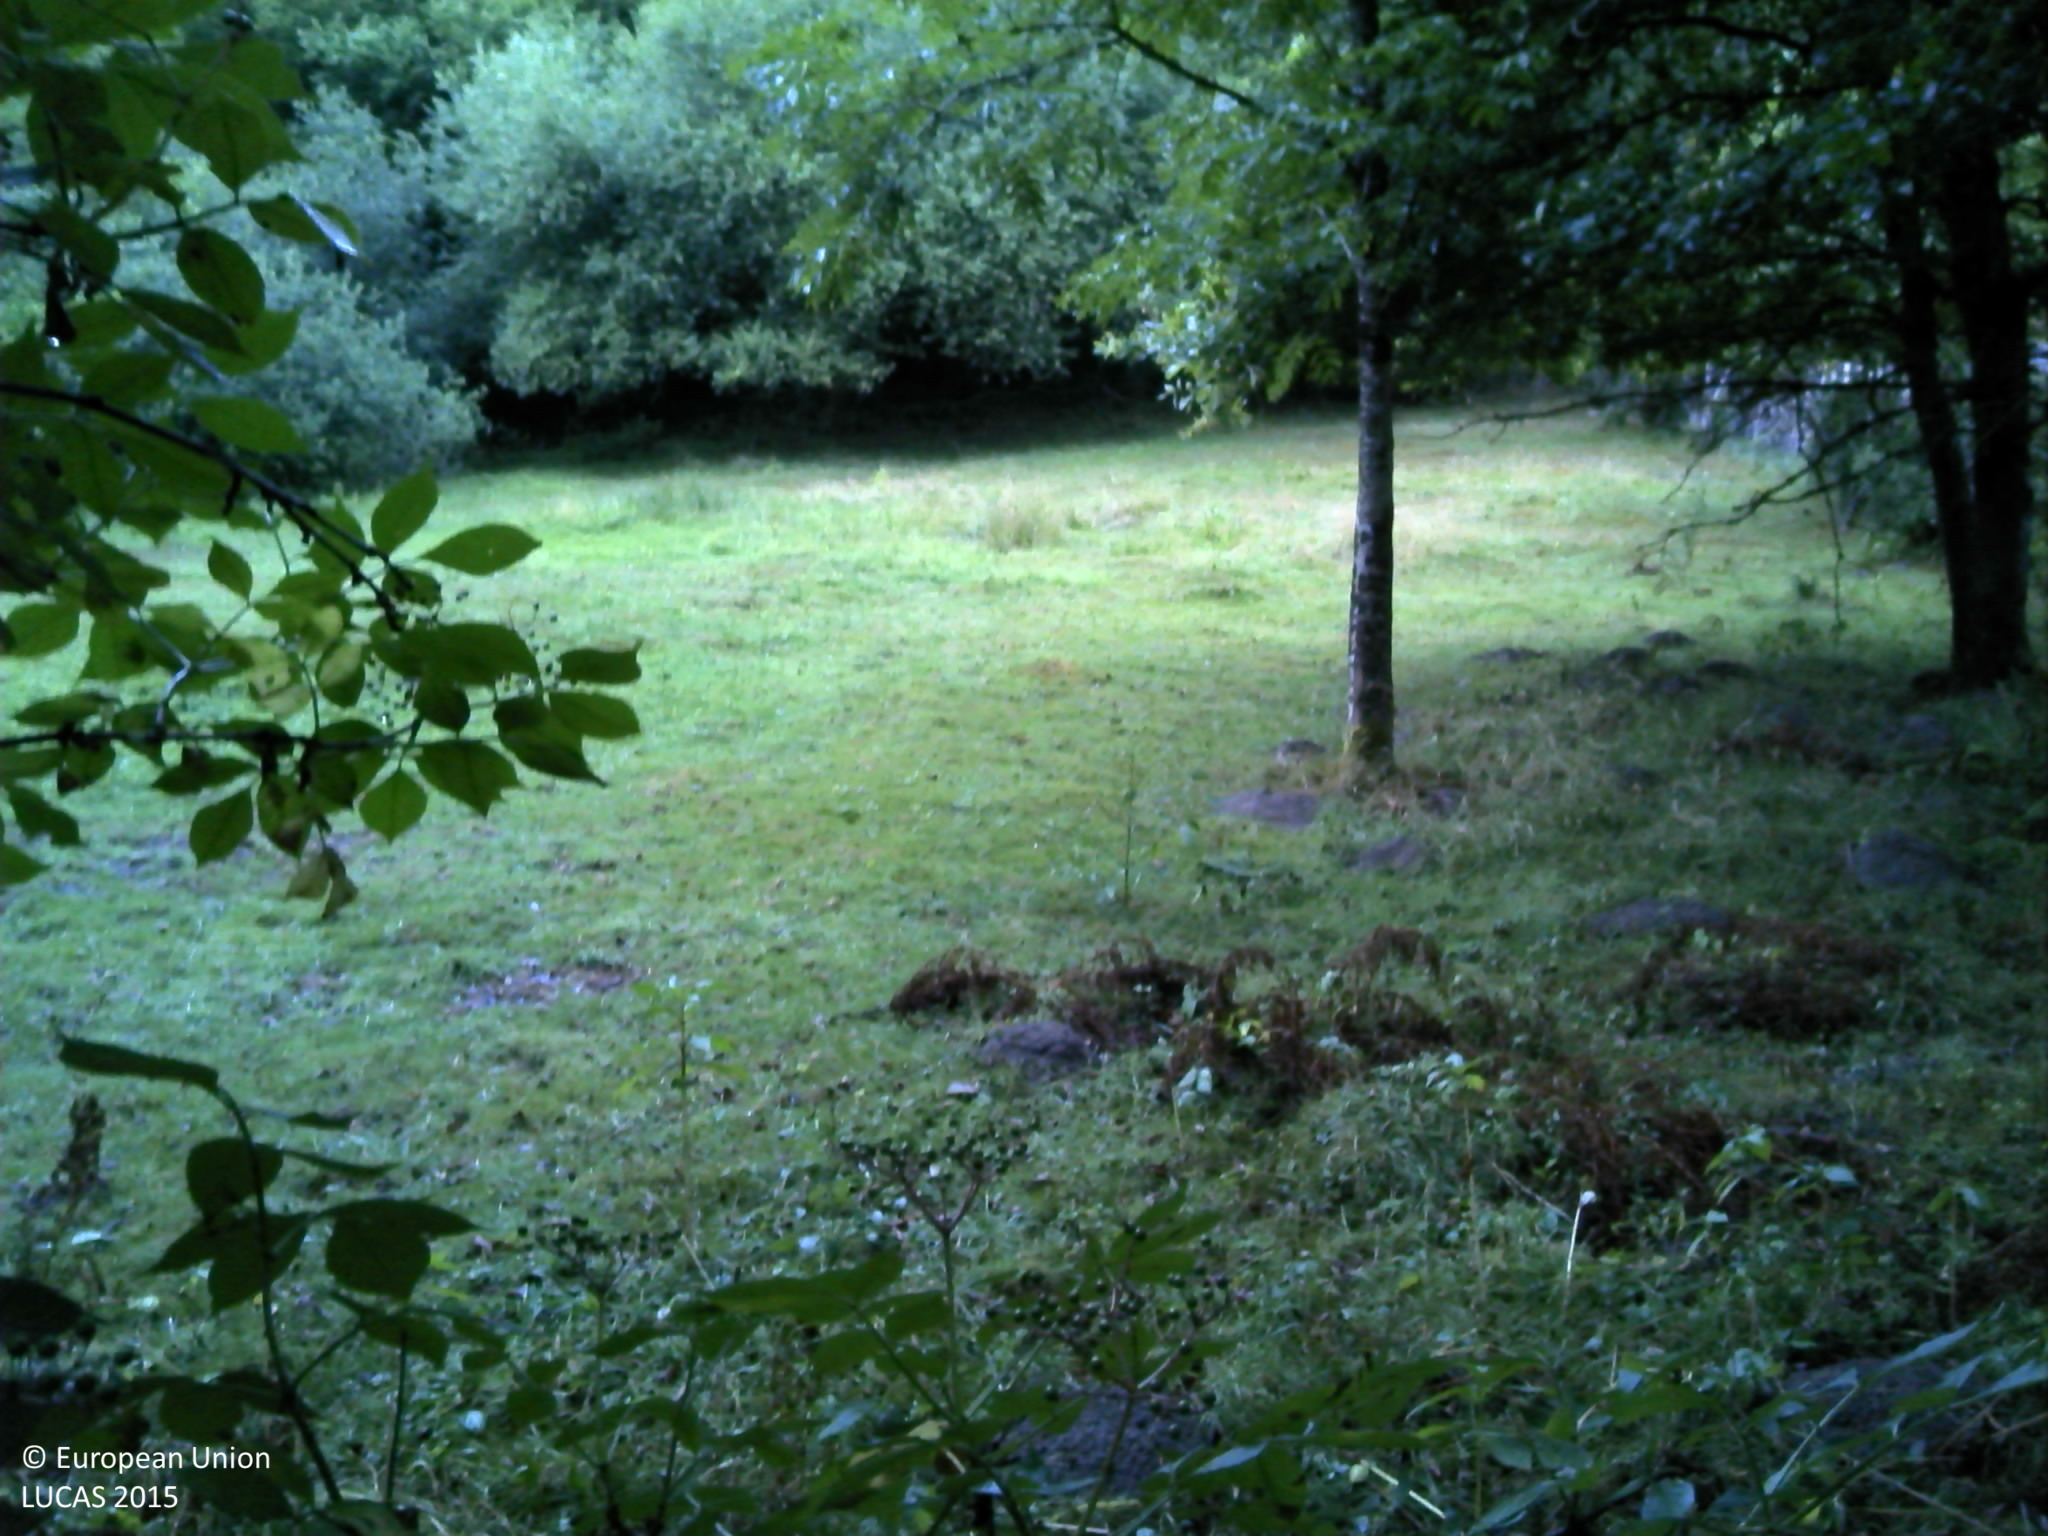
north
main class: Grassland
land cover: Grassland with sparse tree/shrub cover
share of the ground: > 75 %
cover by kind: herbaceous plants 95 %, broadleaved forest trees 5 %
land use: Agriculture (excluding fallow land and kitchen gardens)
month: July
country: FR
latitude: 47.9783
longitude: 6.2095
